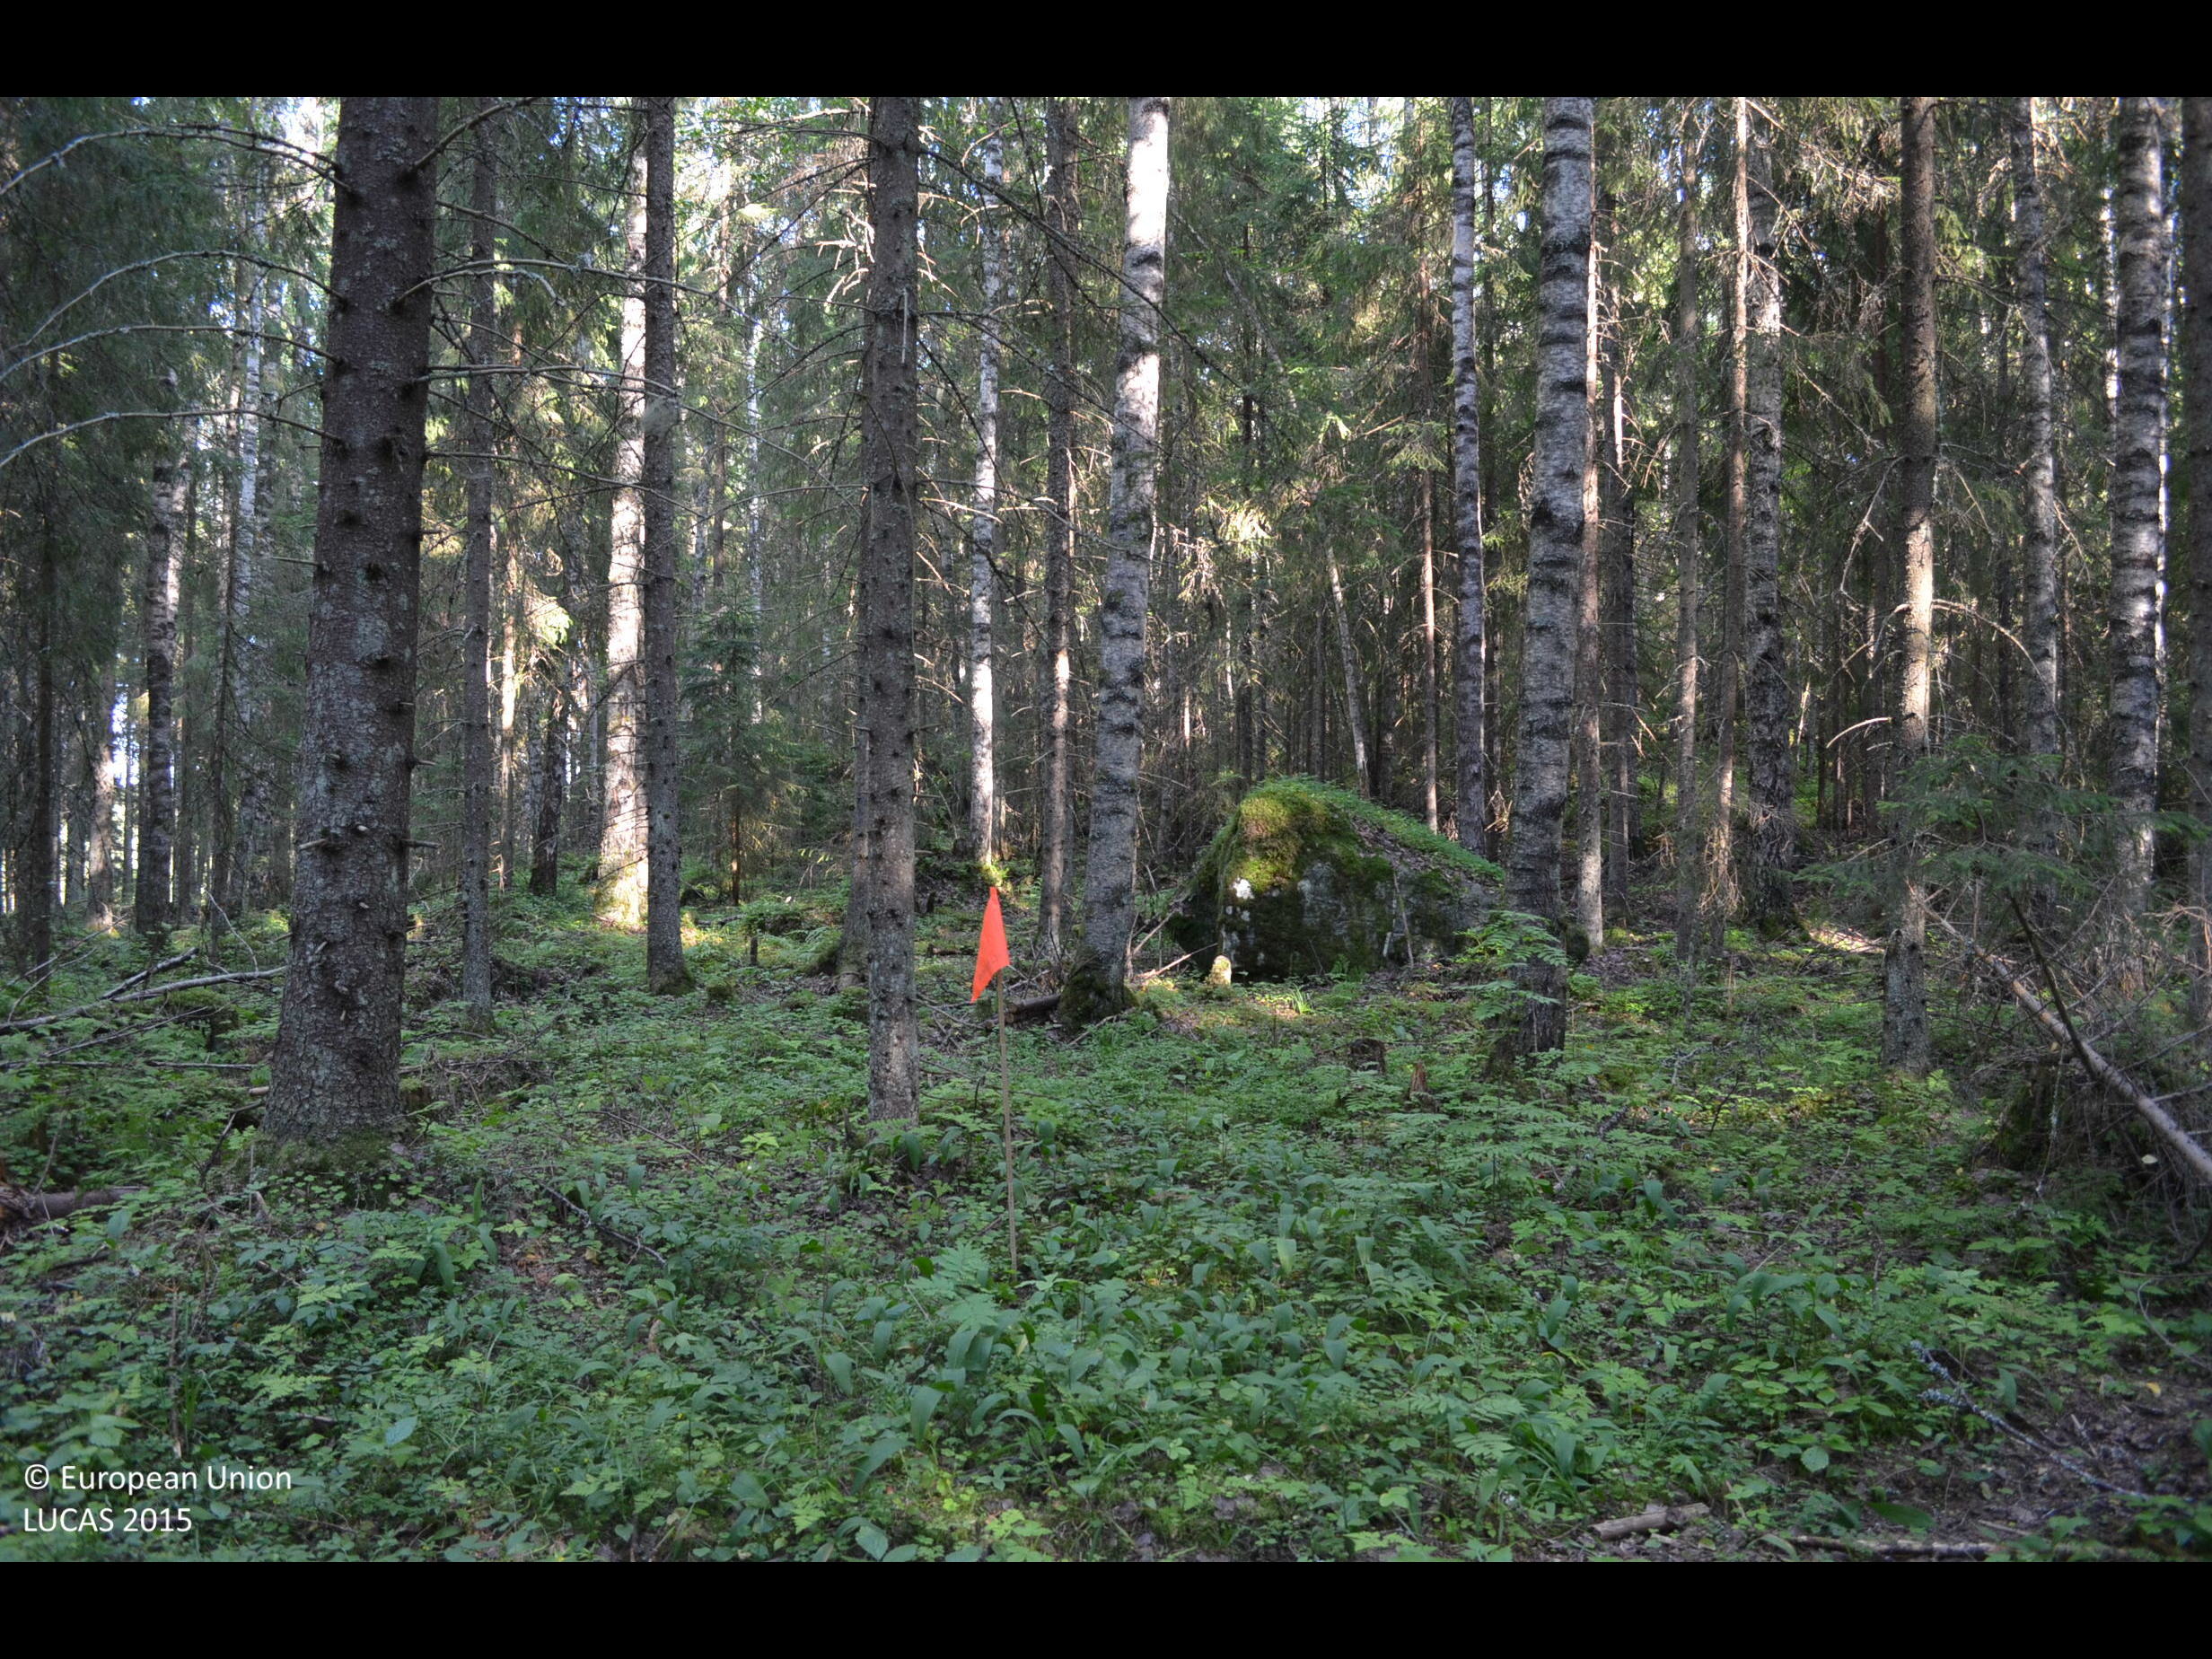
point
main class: Woodland
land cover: Spruce dominated mixed woodland
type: boreal forest
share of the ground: > 75 %
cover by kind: coniferous forest trees 50 %, broadleaved forest trees 40 %, shrubs 5 %, herbaceous plants 5 %
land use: Forestry
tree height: > 5 m
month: August
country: FI
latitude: 61.5802
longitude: 23.0869
